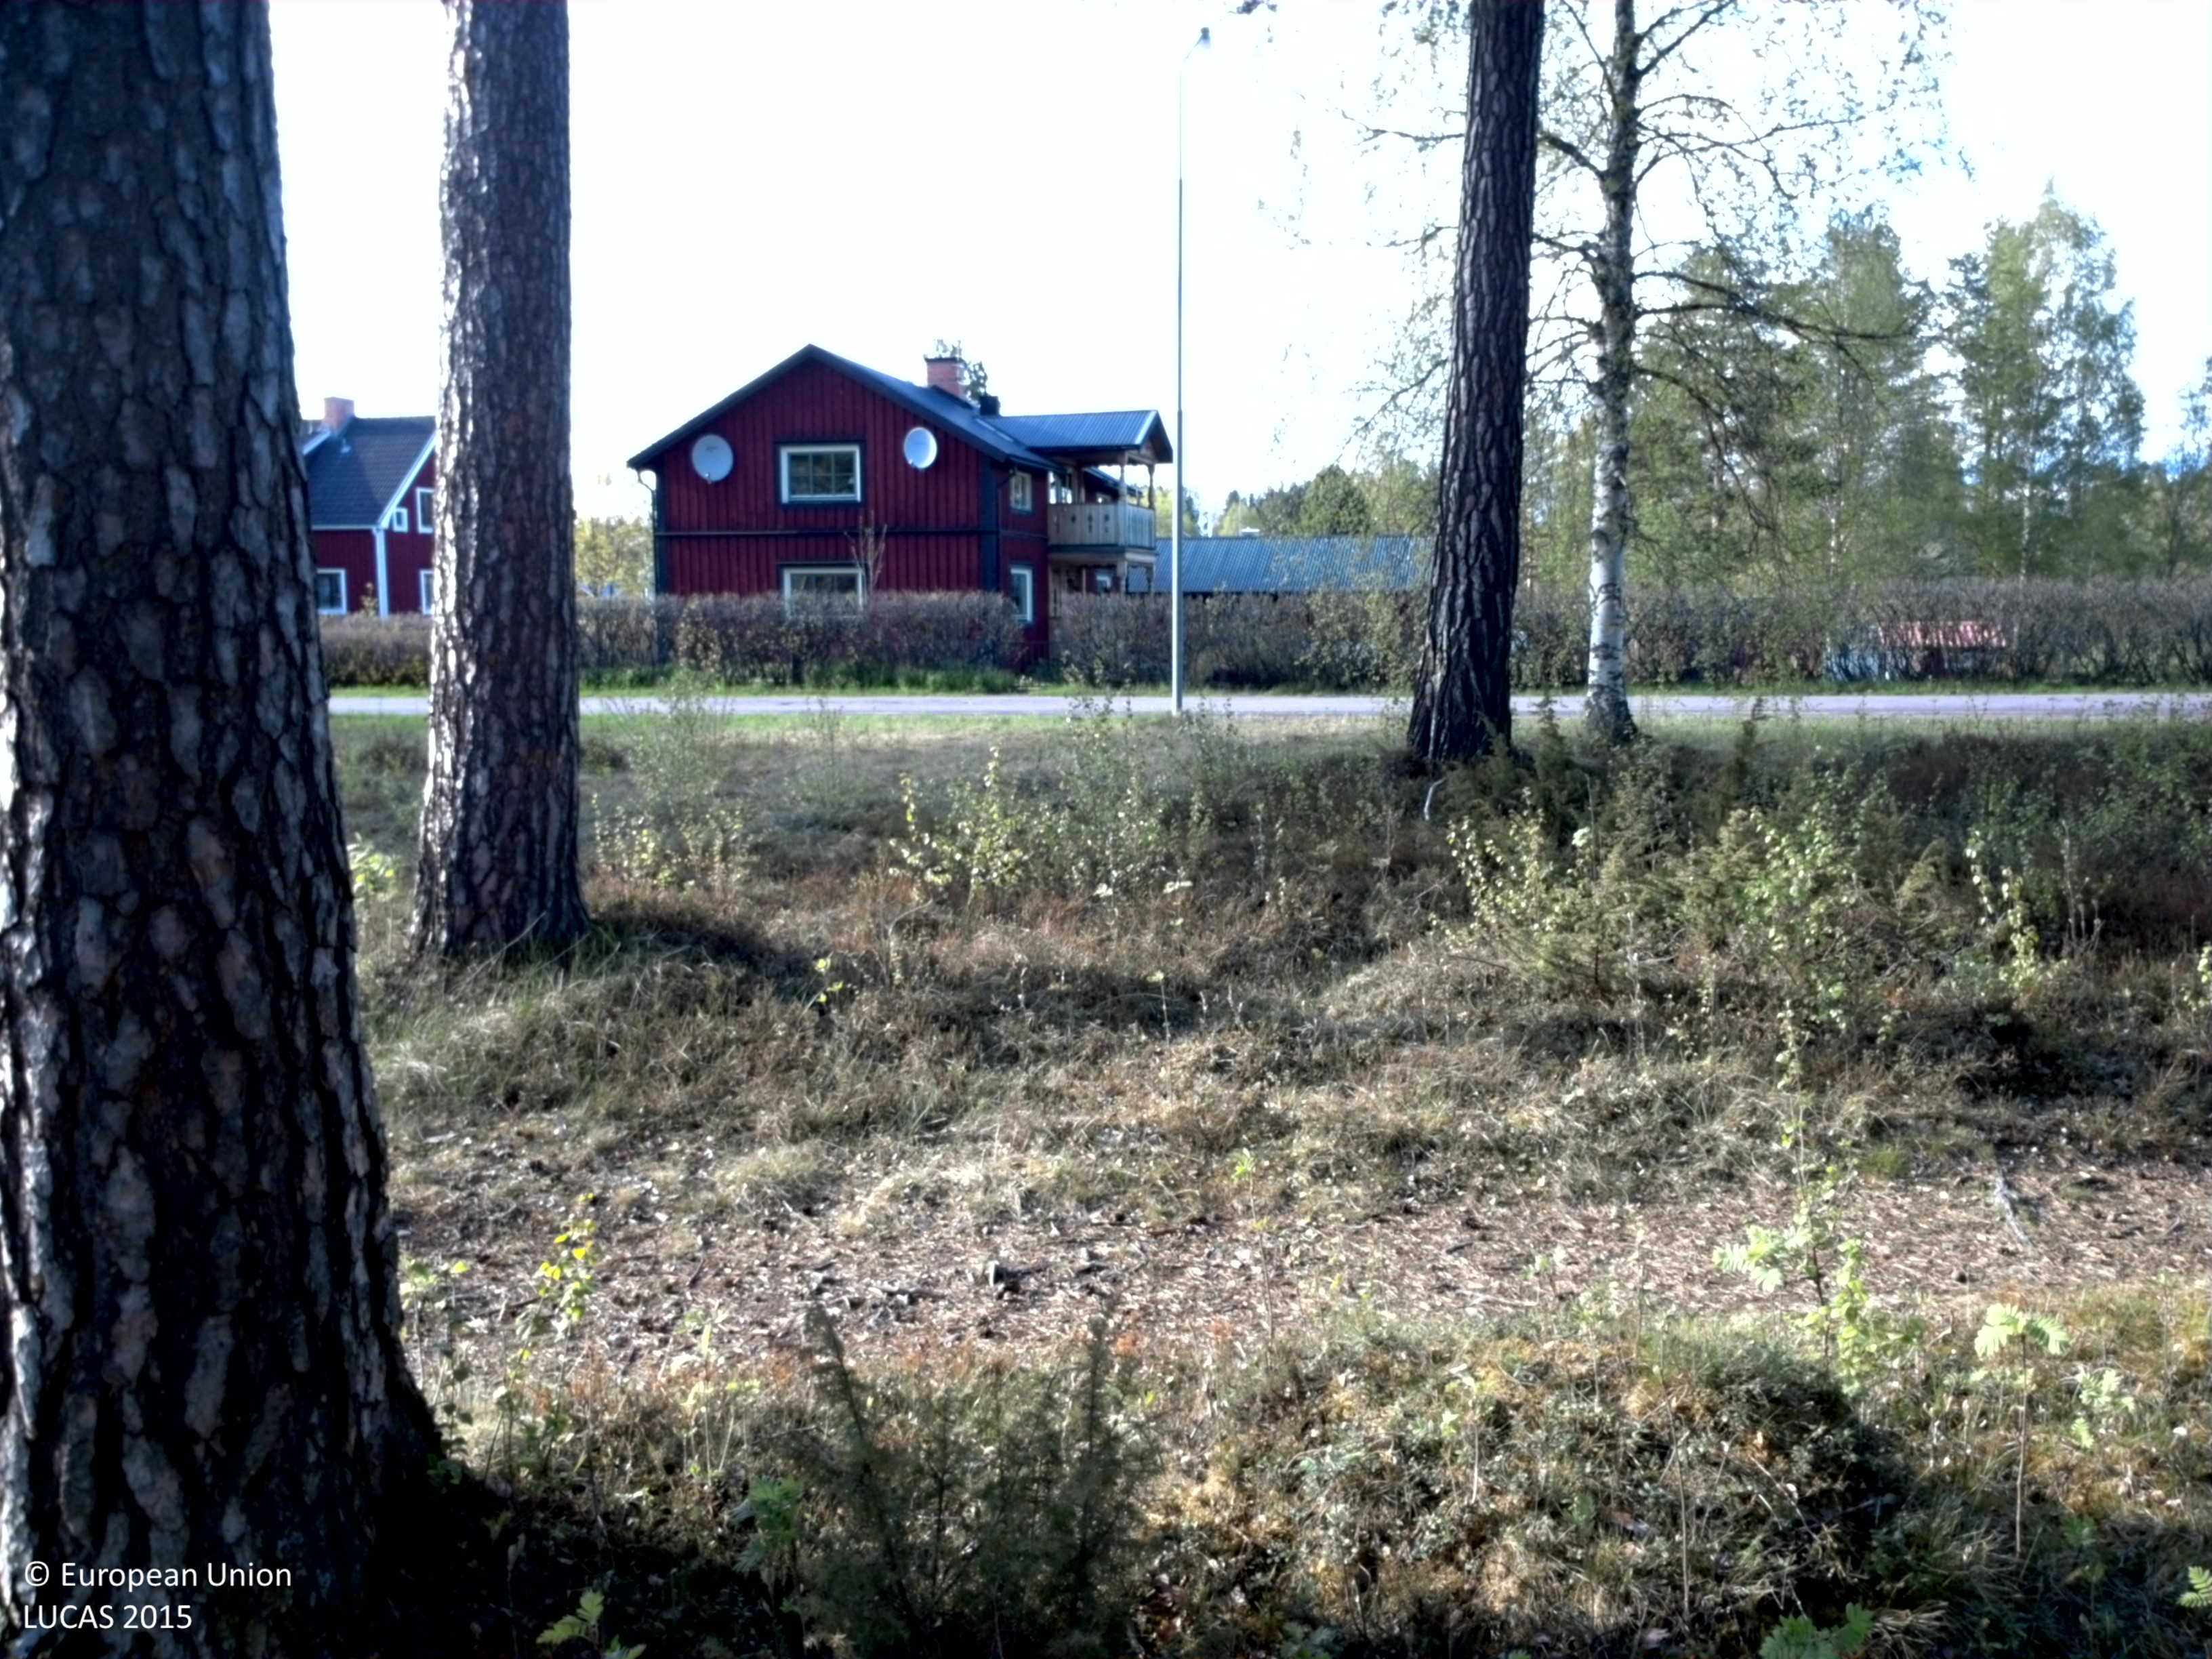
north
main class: Woodland
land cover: Pine dominated mixed woodland
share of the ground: 50 - 75 %
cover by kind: coniferous forest trees 50 %, broadleaved forest trees 20 %, shrubs 15 %, herbaceous plants 15 %
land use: Amenities, museums, leisure
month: May
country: SE
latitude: 61.1701
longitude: 15.1349
